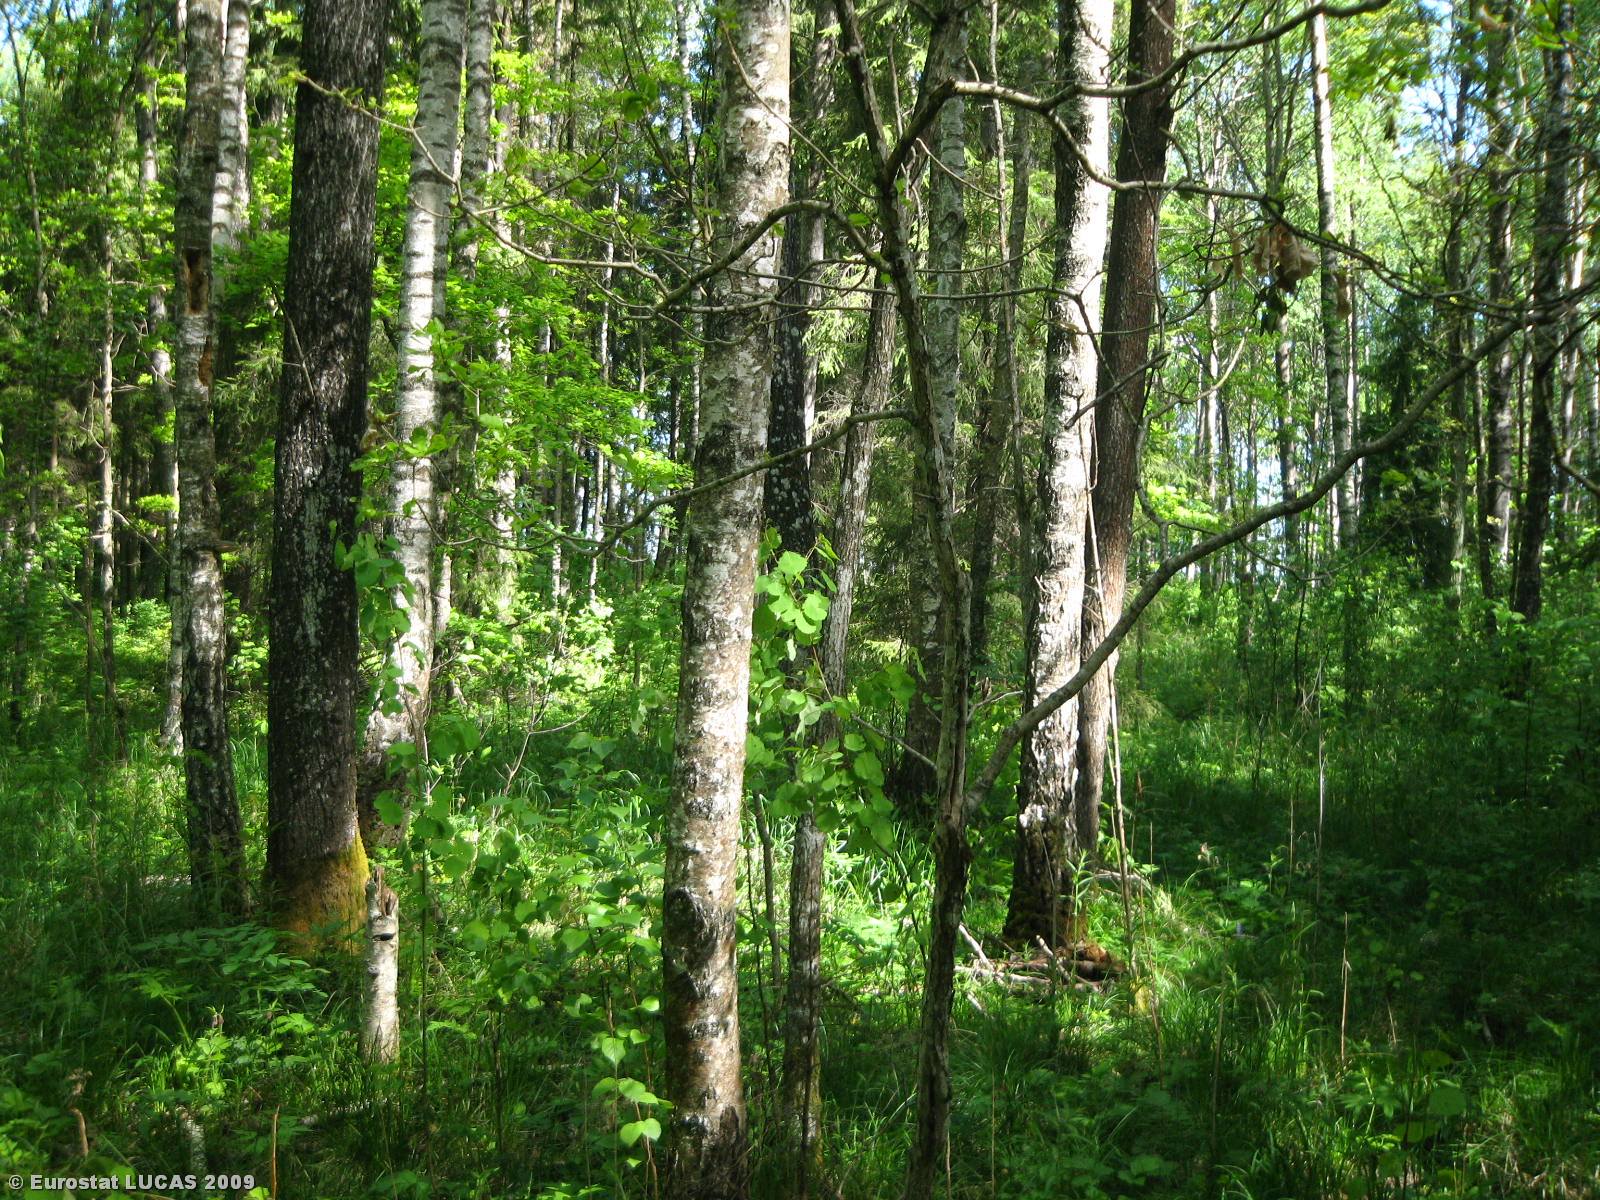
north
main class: Woodland
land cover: Mixed woodland
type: hemiboreal forest and nemoral coniferous forest and mixed broadleaved-coniferous forest
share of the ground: > 75 %
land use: Forestry
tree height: > 5 m
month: May
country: LT
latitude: 56.0258
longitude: 24.0969
